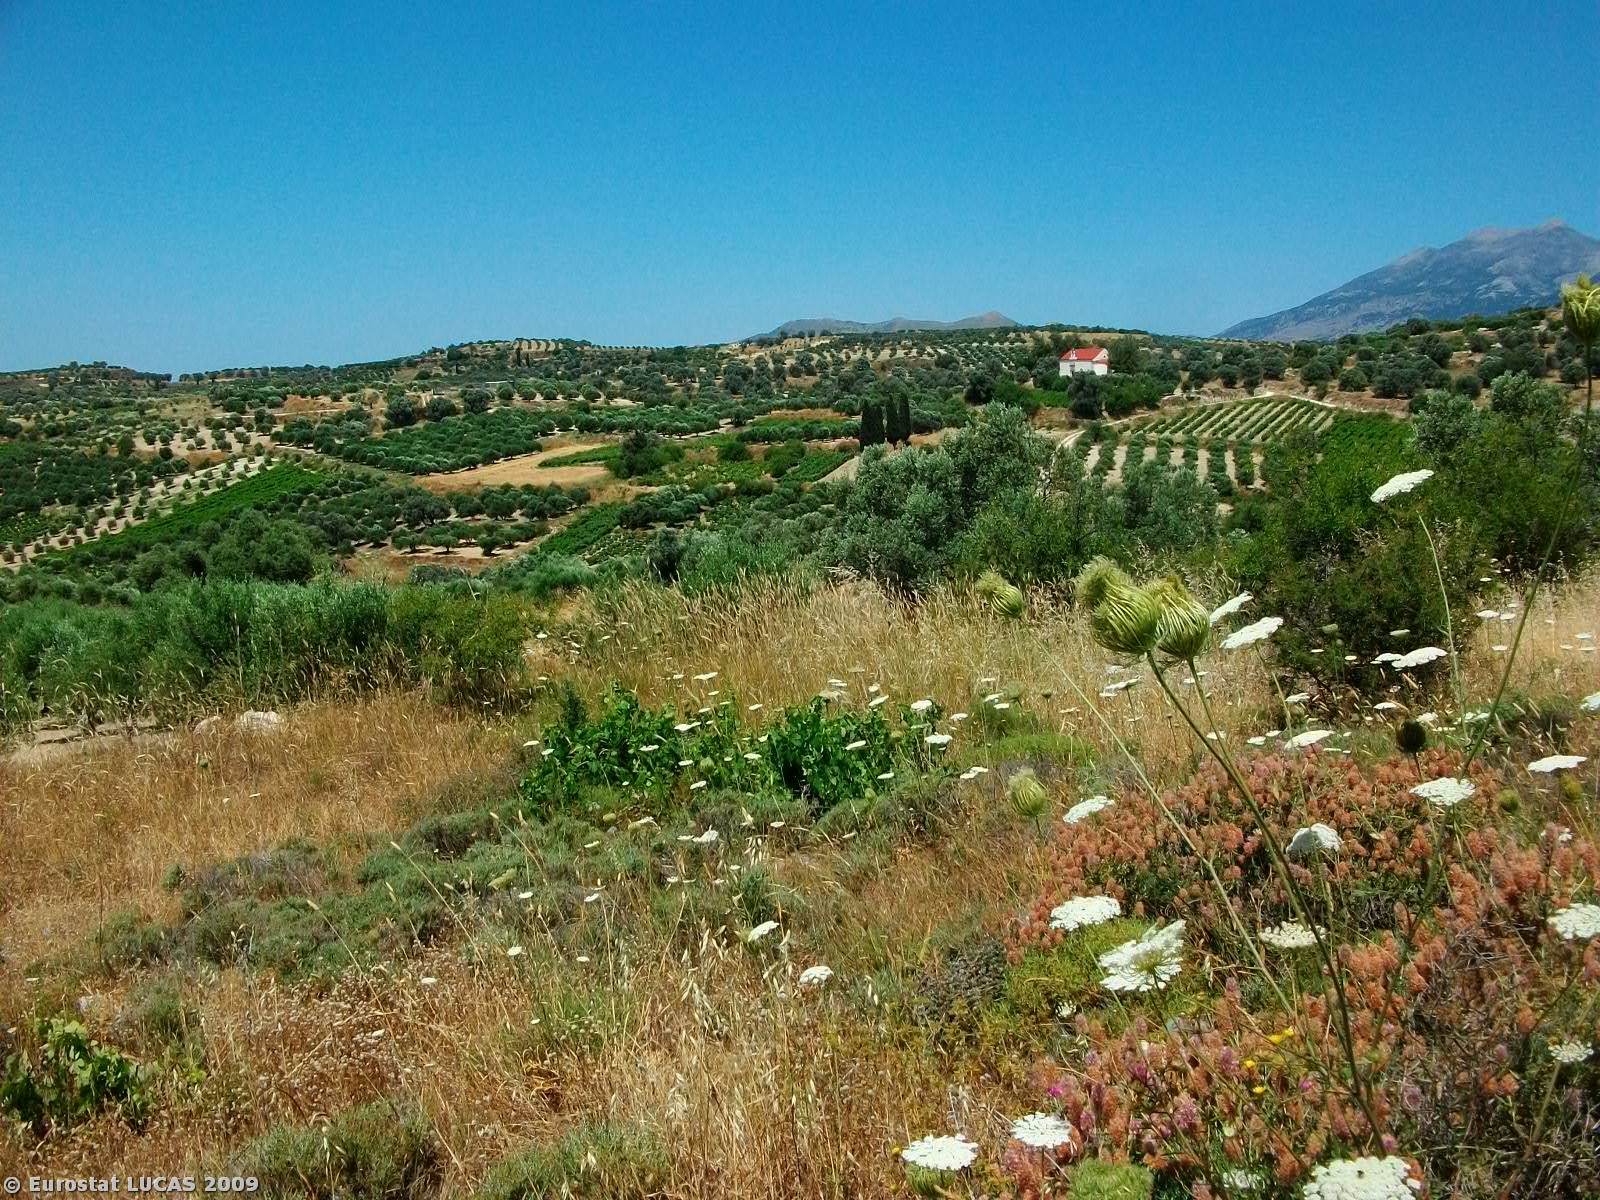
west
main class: Shrubland
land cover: Shrubland with sparse tree cover
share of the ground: > 75 %
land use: Unused
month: June
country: GR
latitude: 35.1047
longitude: 24.9397
